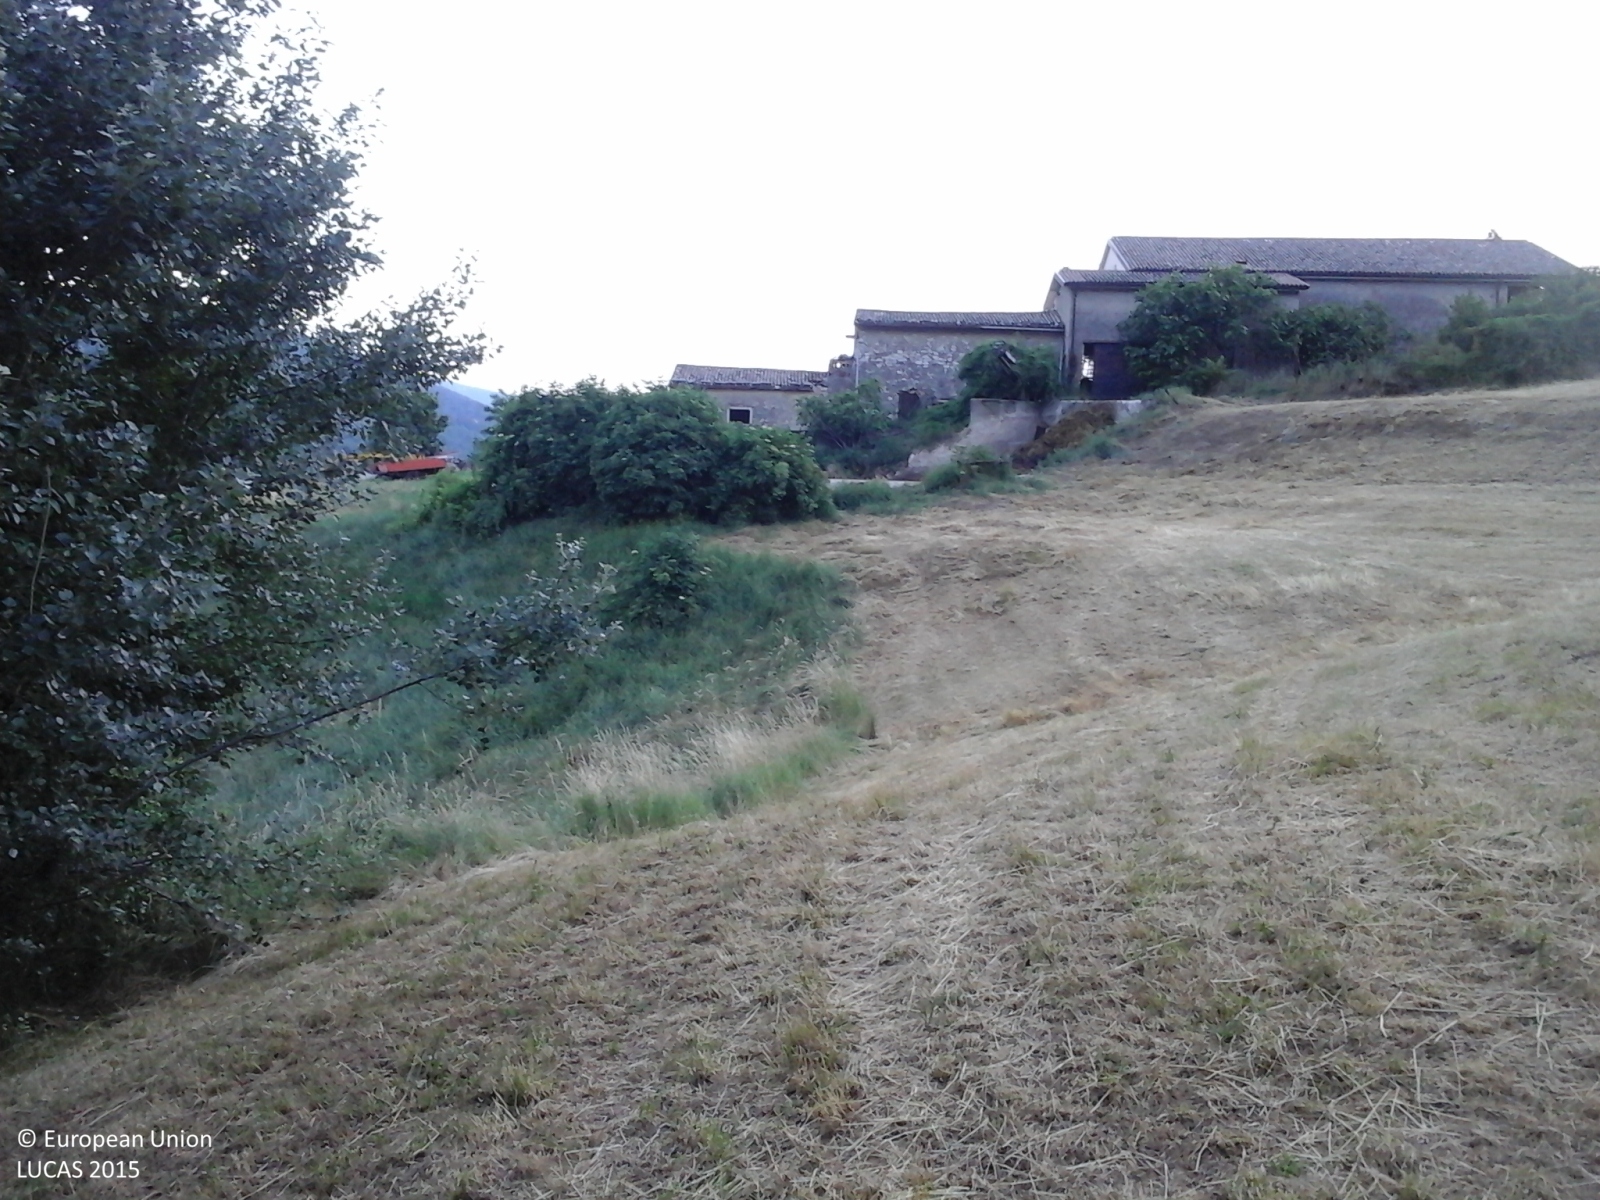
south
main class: Grassland
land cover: Grassland without tree/shrub cover
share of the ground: > 75 %
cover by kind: herbaceous plants 100 %
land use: Agriculture (excluding fallow land and kitchen gardens)
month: June
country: IT
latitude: 45.6273
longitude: 10.8324
